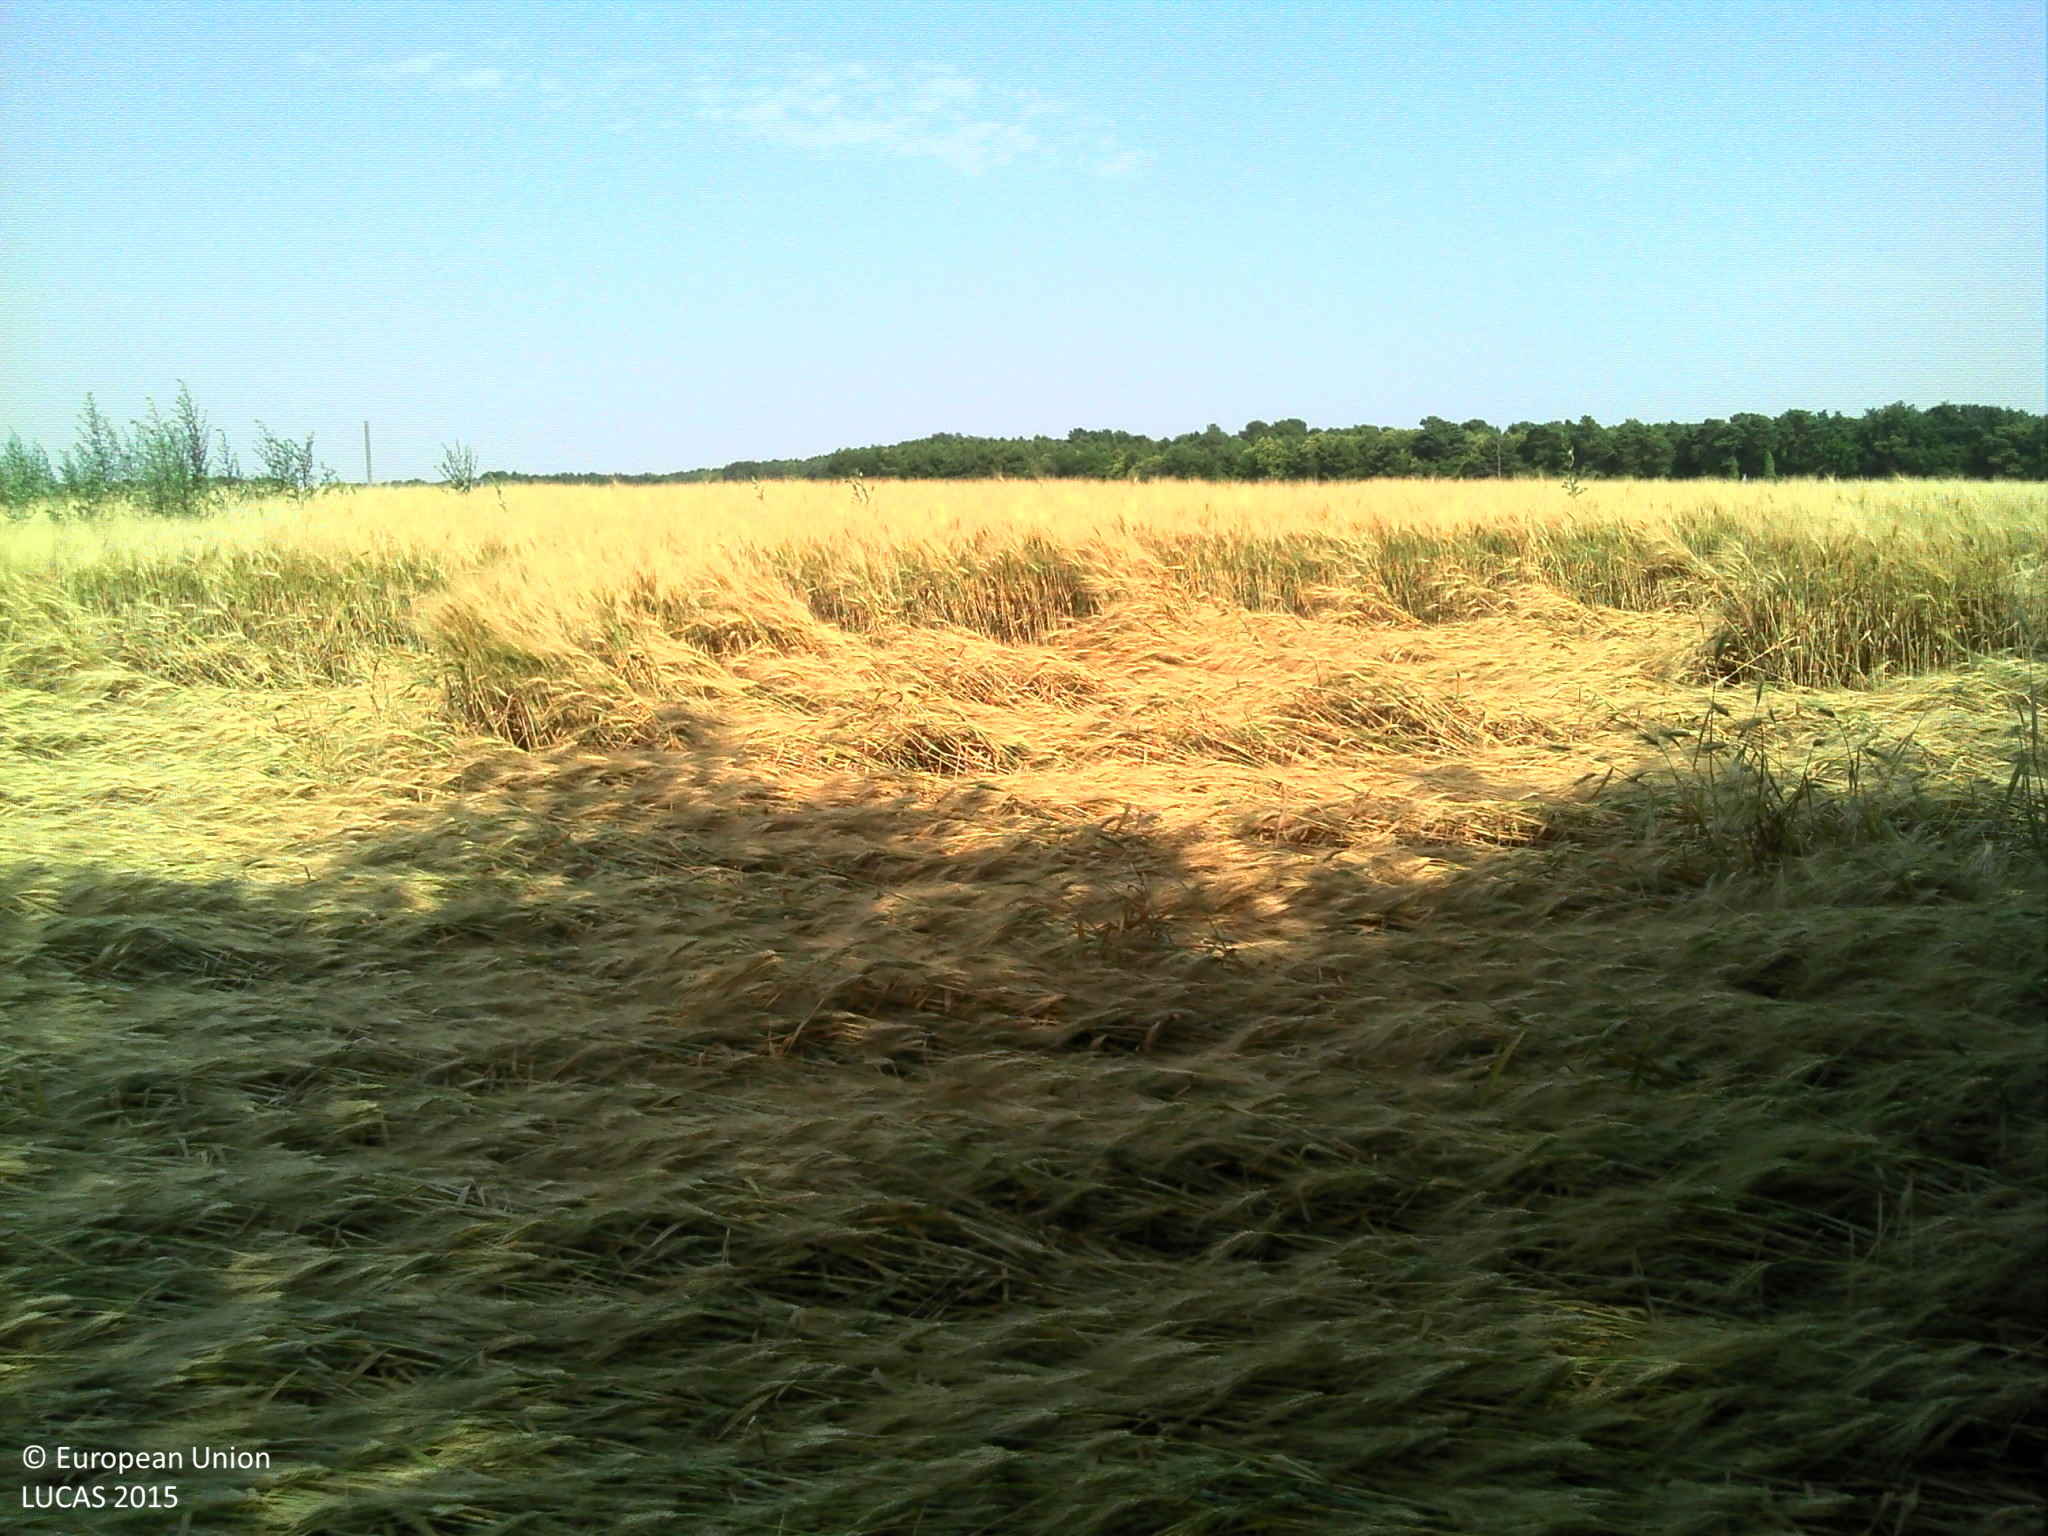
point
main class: Cropland
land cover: Triticale
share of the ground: > 75 %
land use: Agriculture (excluding fallow land and kitchen gardens)
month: July
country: FR
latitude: 46.8807
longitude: 0.4143
